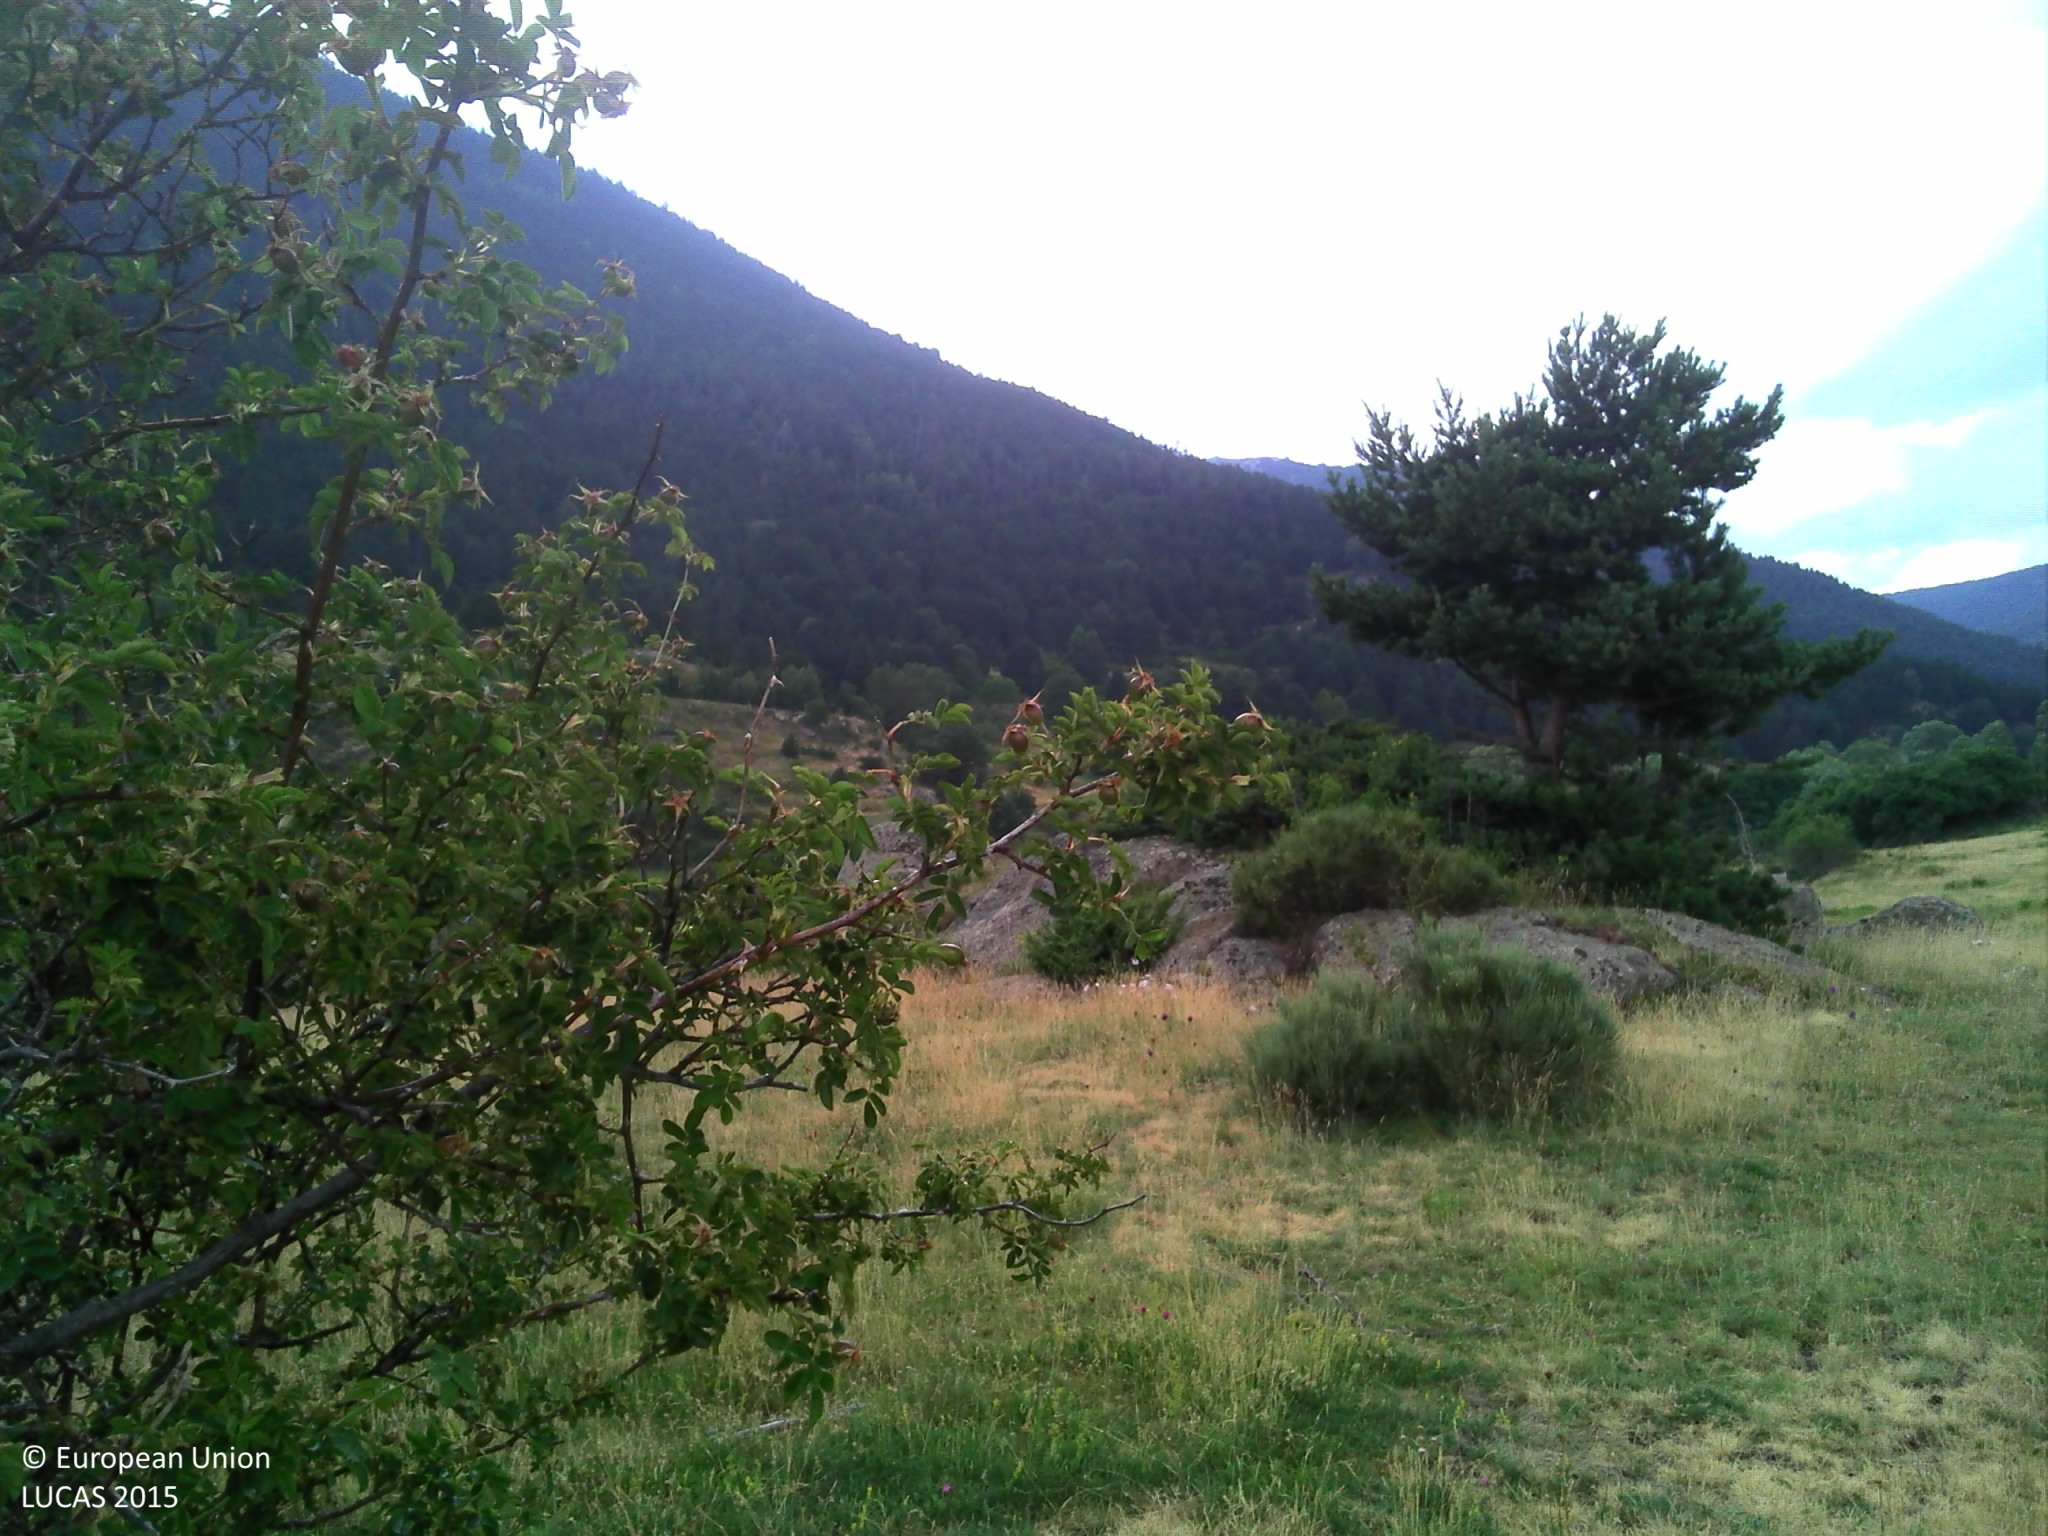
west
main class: Shrubland
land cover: Shrubland without tree cover
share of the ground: > 75 %
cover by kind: herbaceous plants 70 %, shrubs 20 %, consolidated bare surface 10 %
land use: Agriculture (excluding fallow land and kitchen gardens)
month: July
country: FR
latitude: 42.5868
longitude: 2.1757
